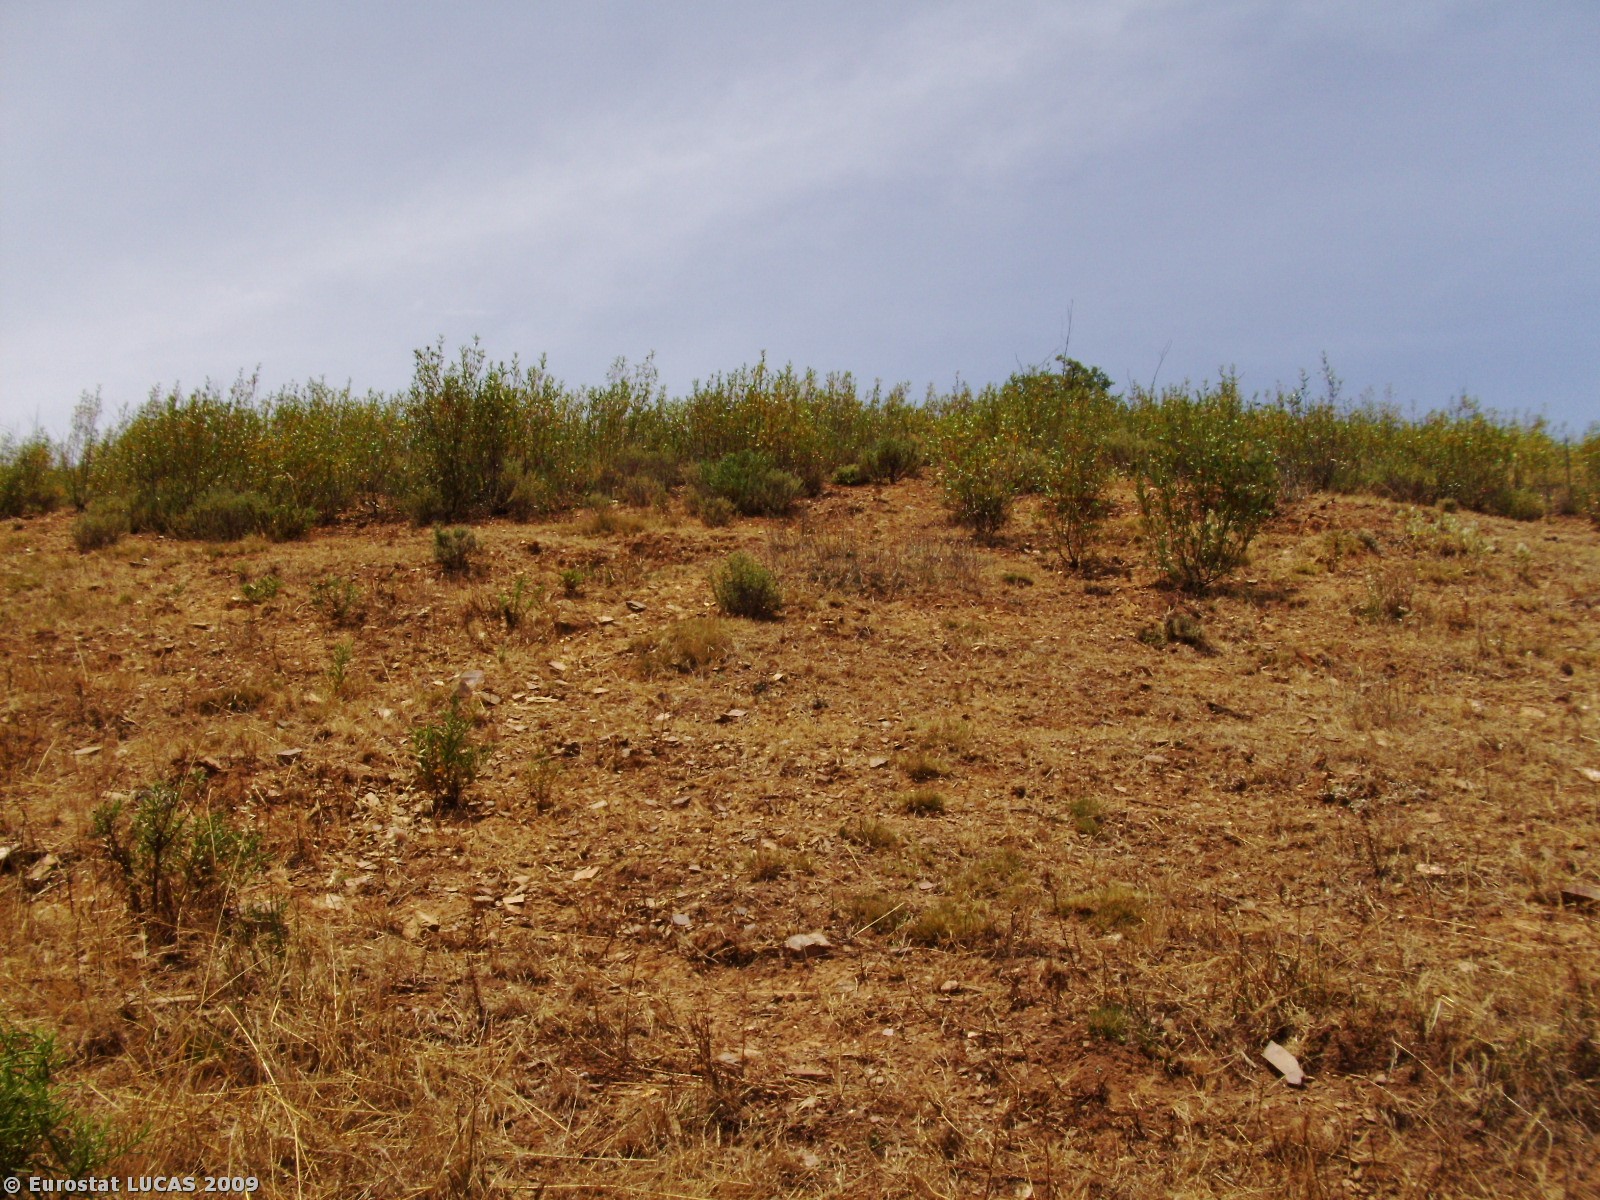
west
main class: Grassland
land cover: Spontaneously vegetated surfaces
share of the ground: 50 - 75 %
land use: Fallow land
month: June
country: PT
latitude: 37.4333
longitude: -8.5091
